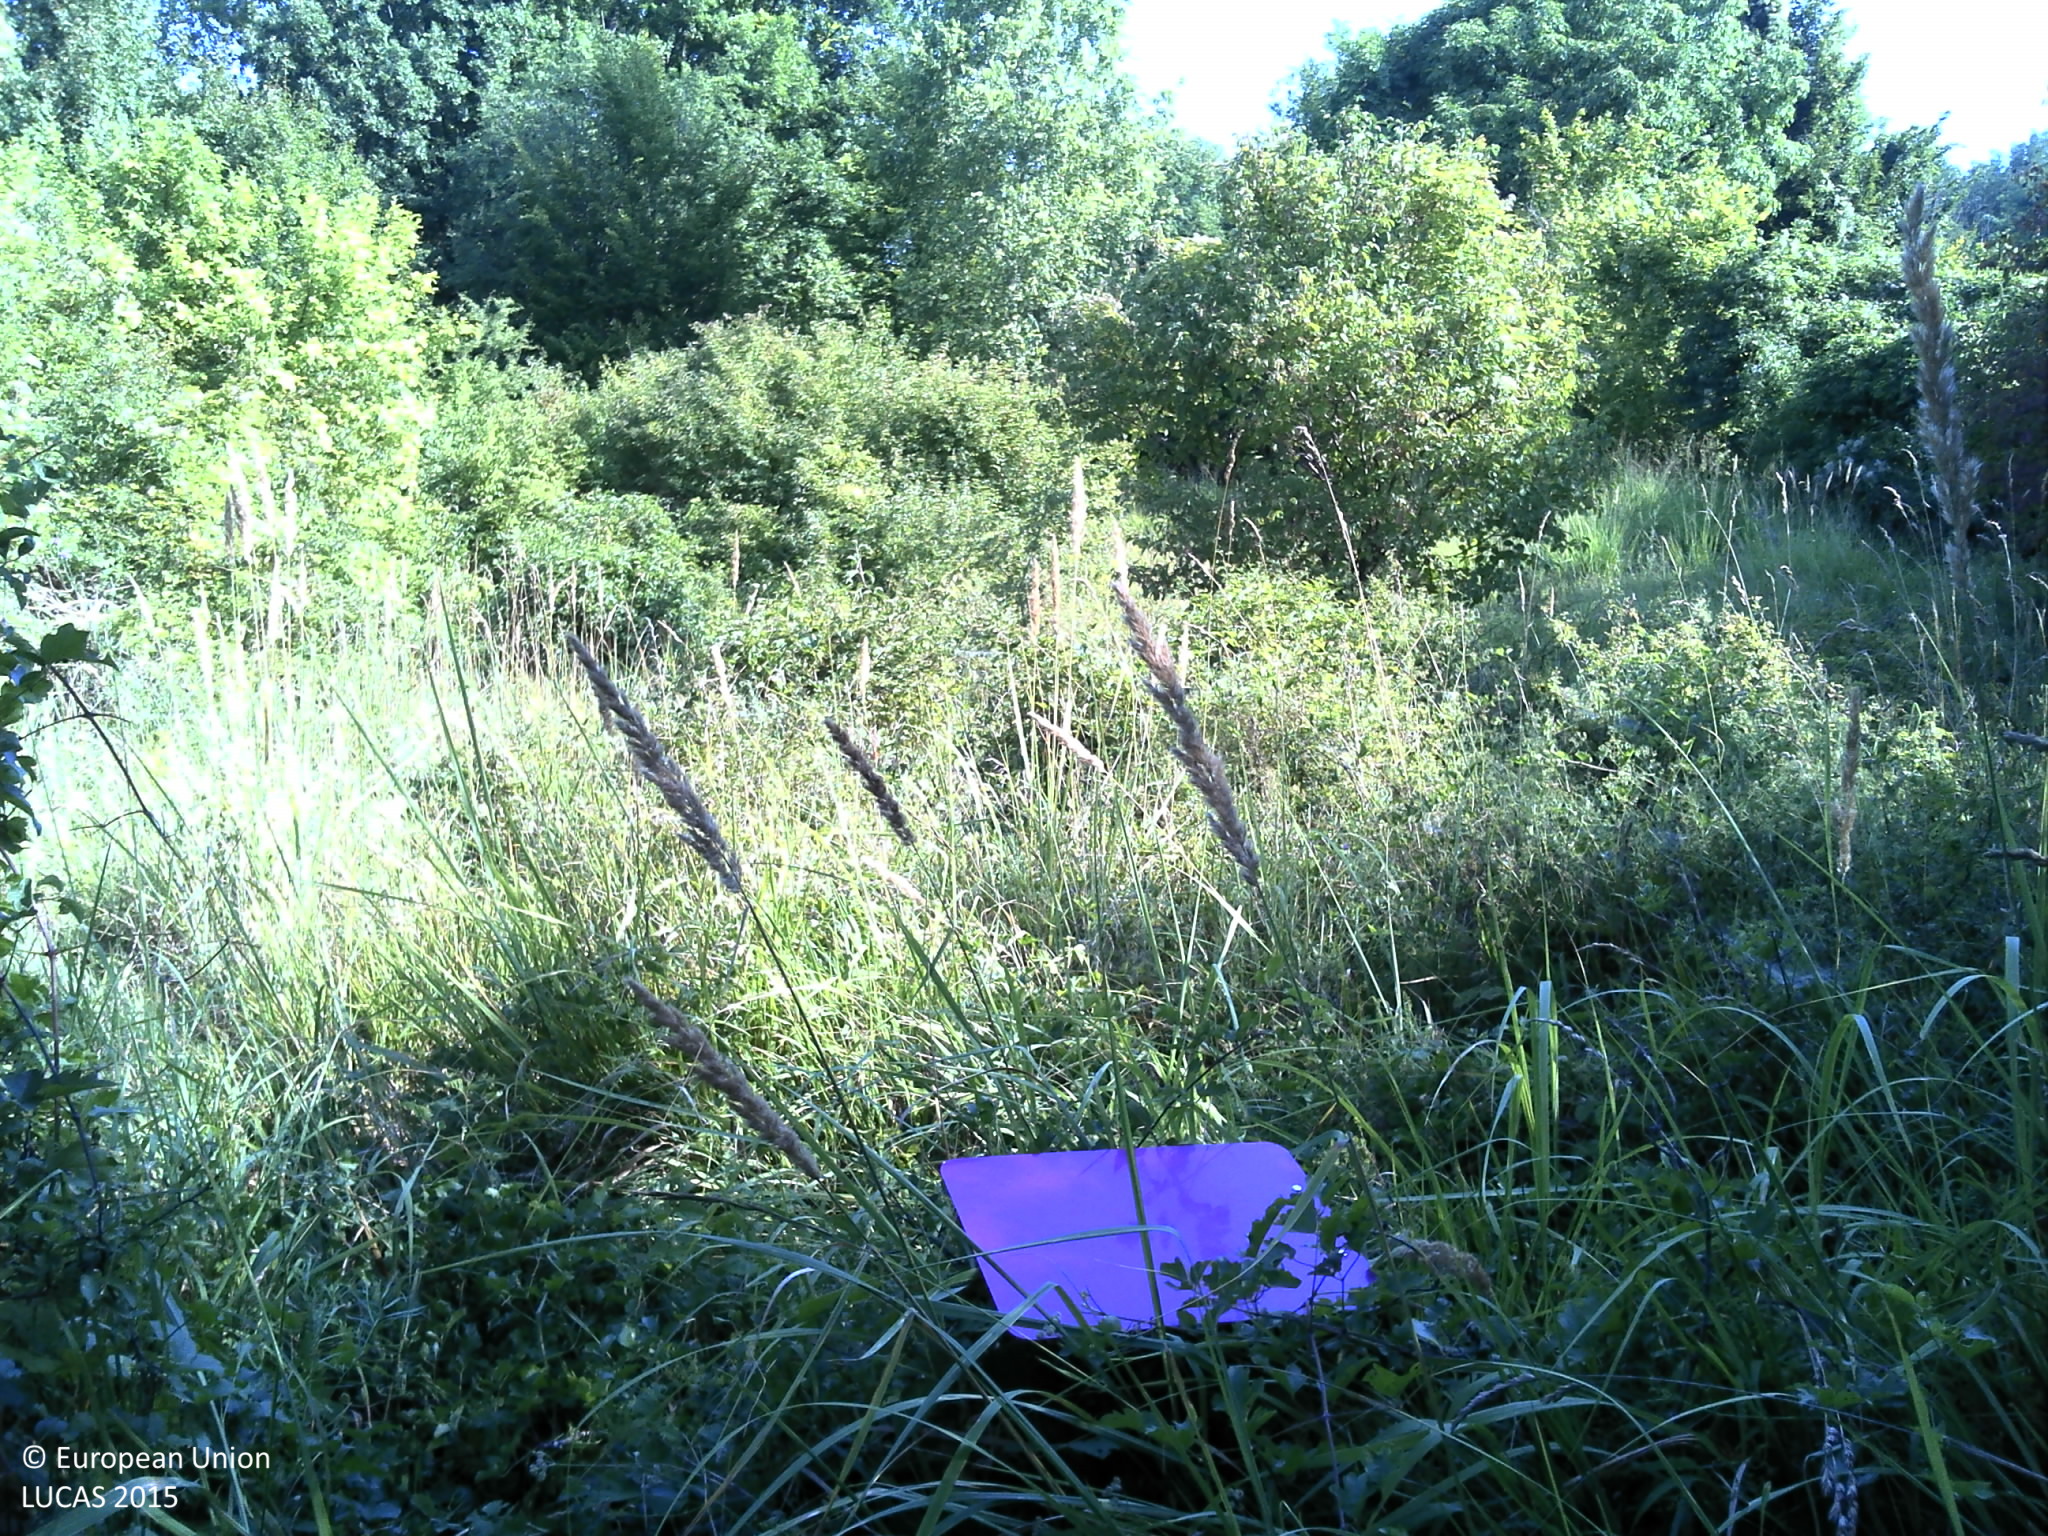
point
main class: Grassland
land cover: Spontaneously vegetated surfaces
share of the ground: > 75 %
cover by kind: herbaceous plants 100 %
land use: Semi-natural and natural areas not in use
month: August
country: HR
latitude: 45.5615
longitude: 17.2650
